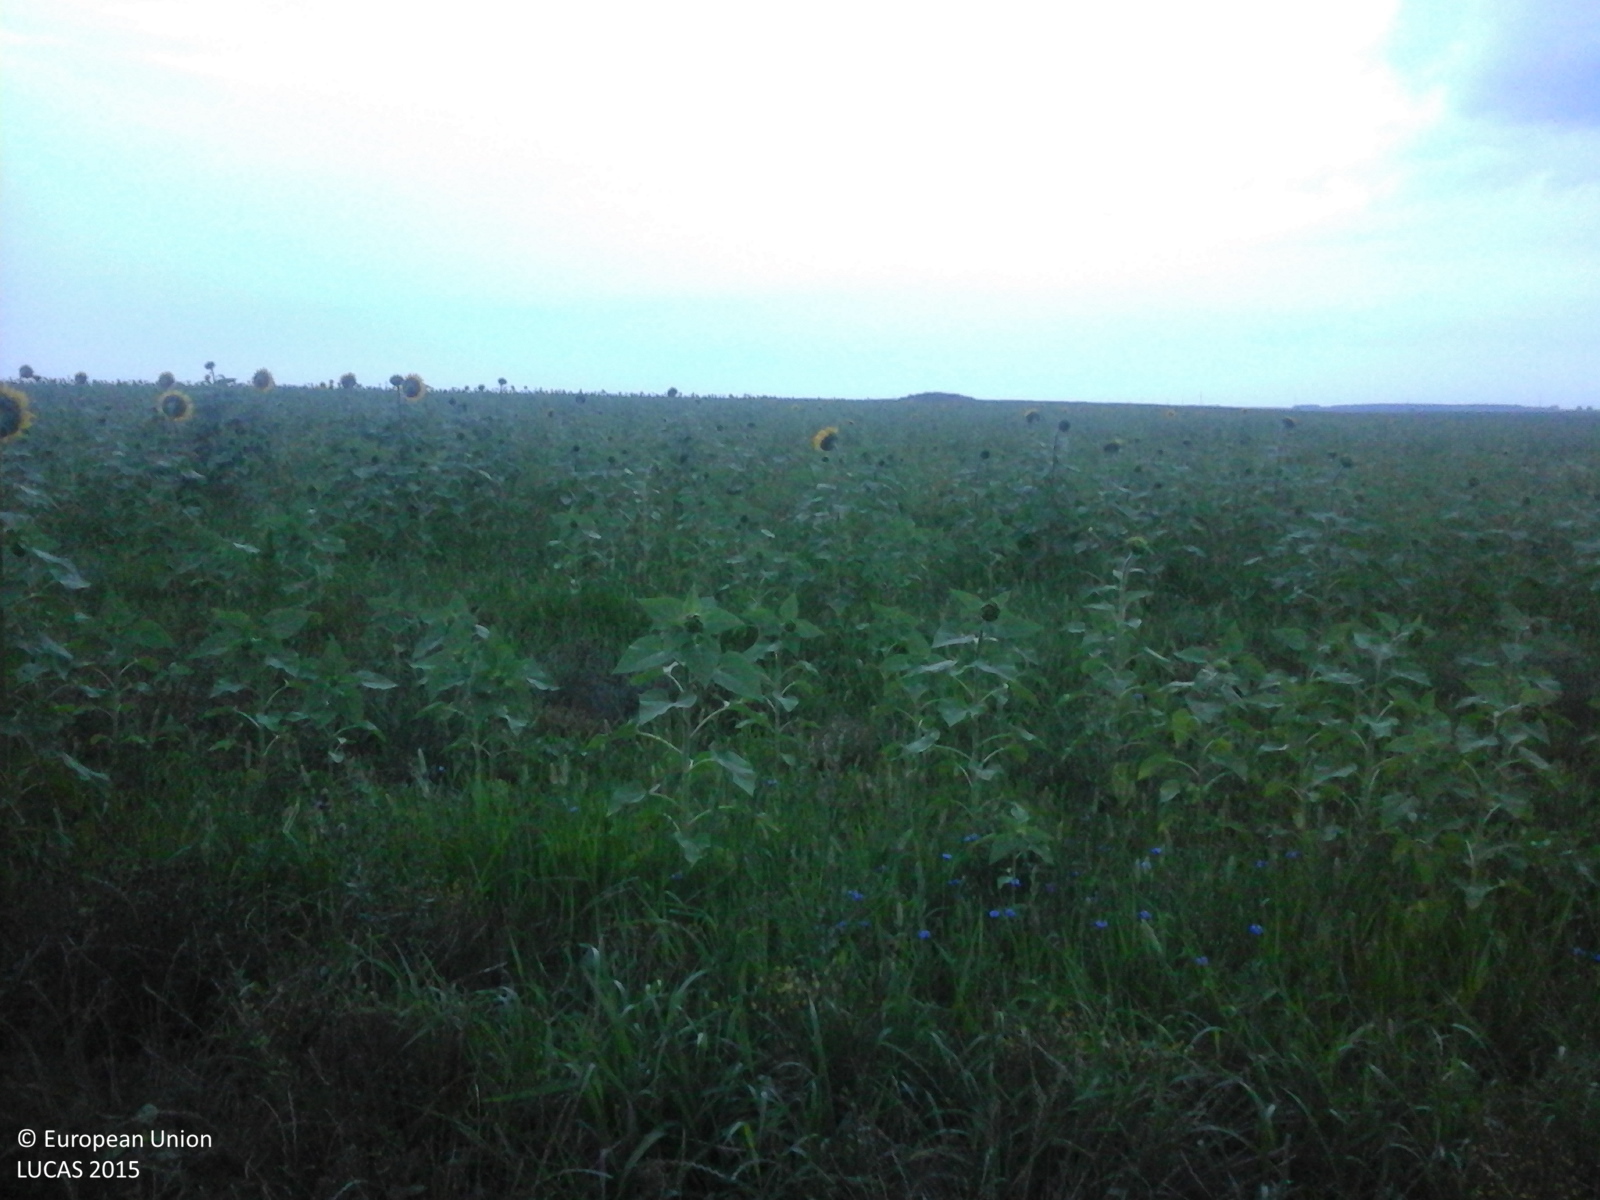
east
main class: Cropland
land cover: Maize
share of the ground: > 75 %
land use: Agriculture (excluding fallow land and kitchen gardens)
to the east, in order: Maize; Tracks; Sunflower
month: July
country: RO
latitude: 44.0910
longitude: 24.2641
